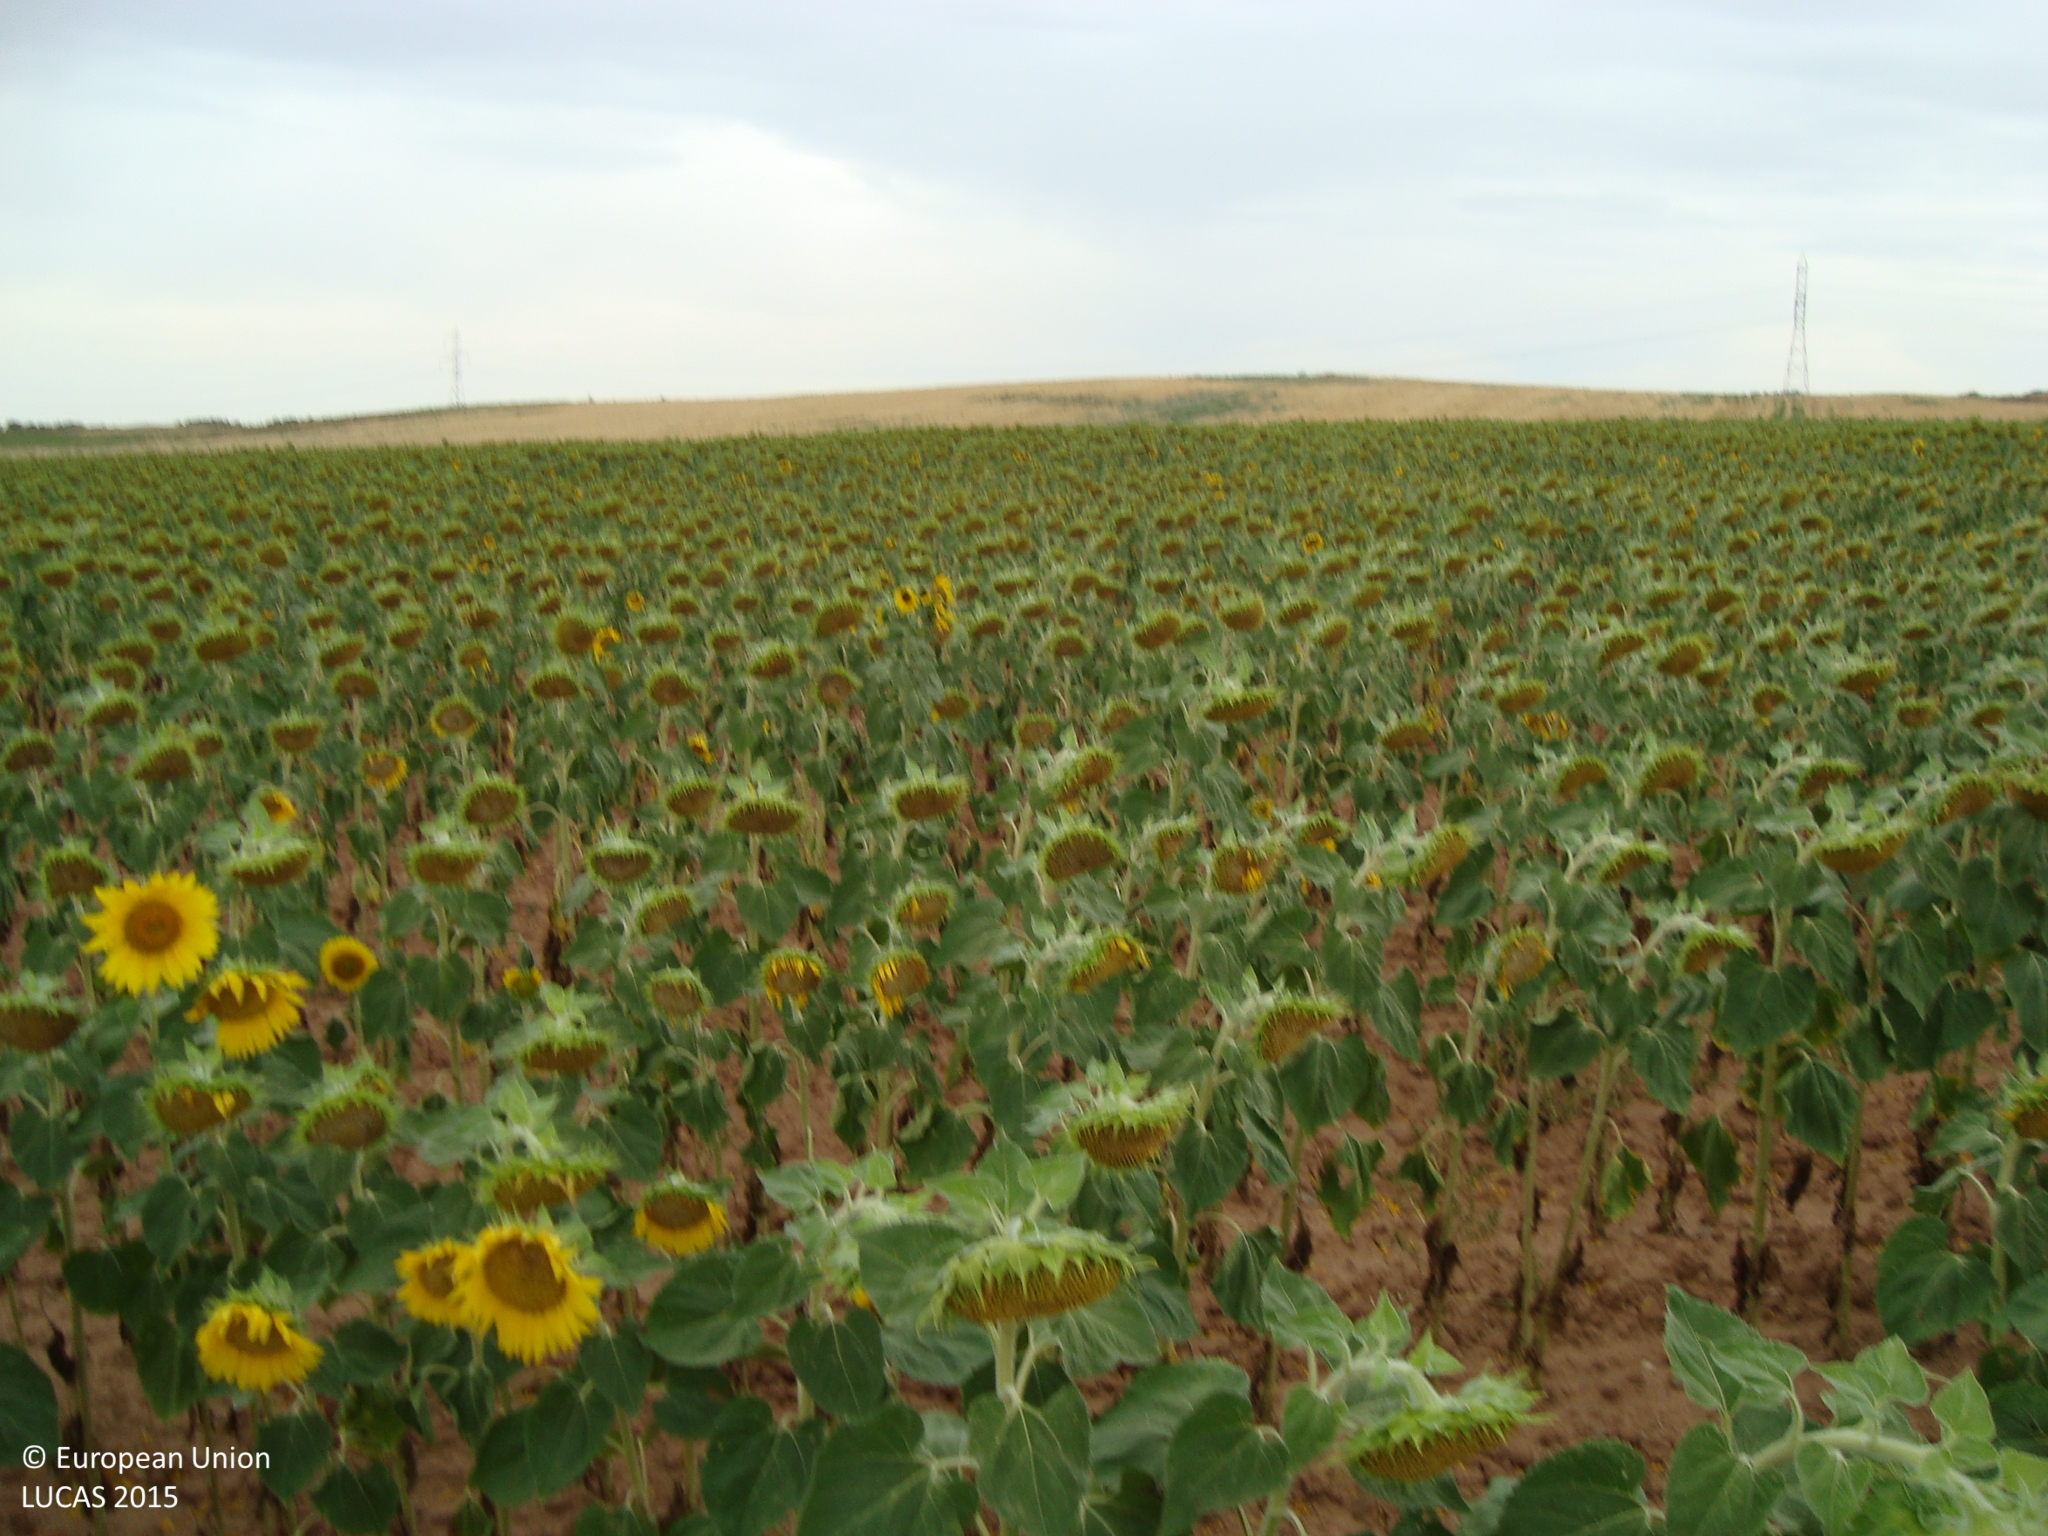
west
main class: Cropland
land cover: Sunflower
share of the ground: > 75 %
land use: Agriculture (excluding fallow land and kitchen gardens)
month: August
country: ES
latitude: 42.2053
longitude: -3.8814
